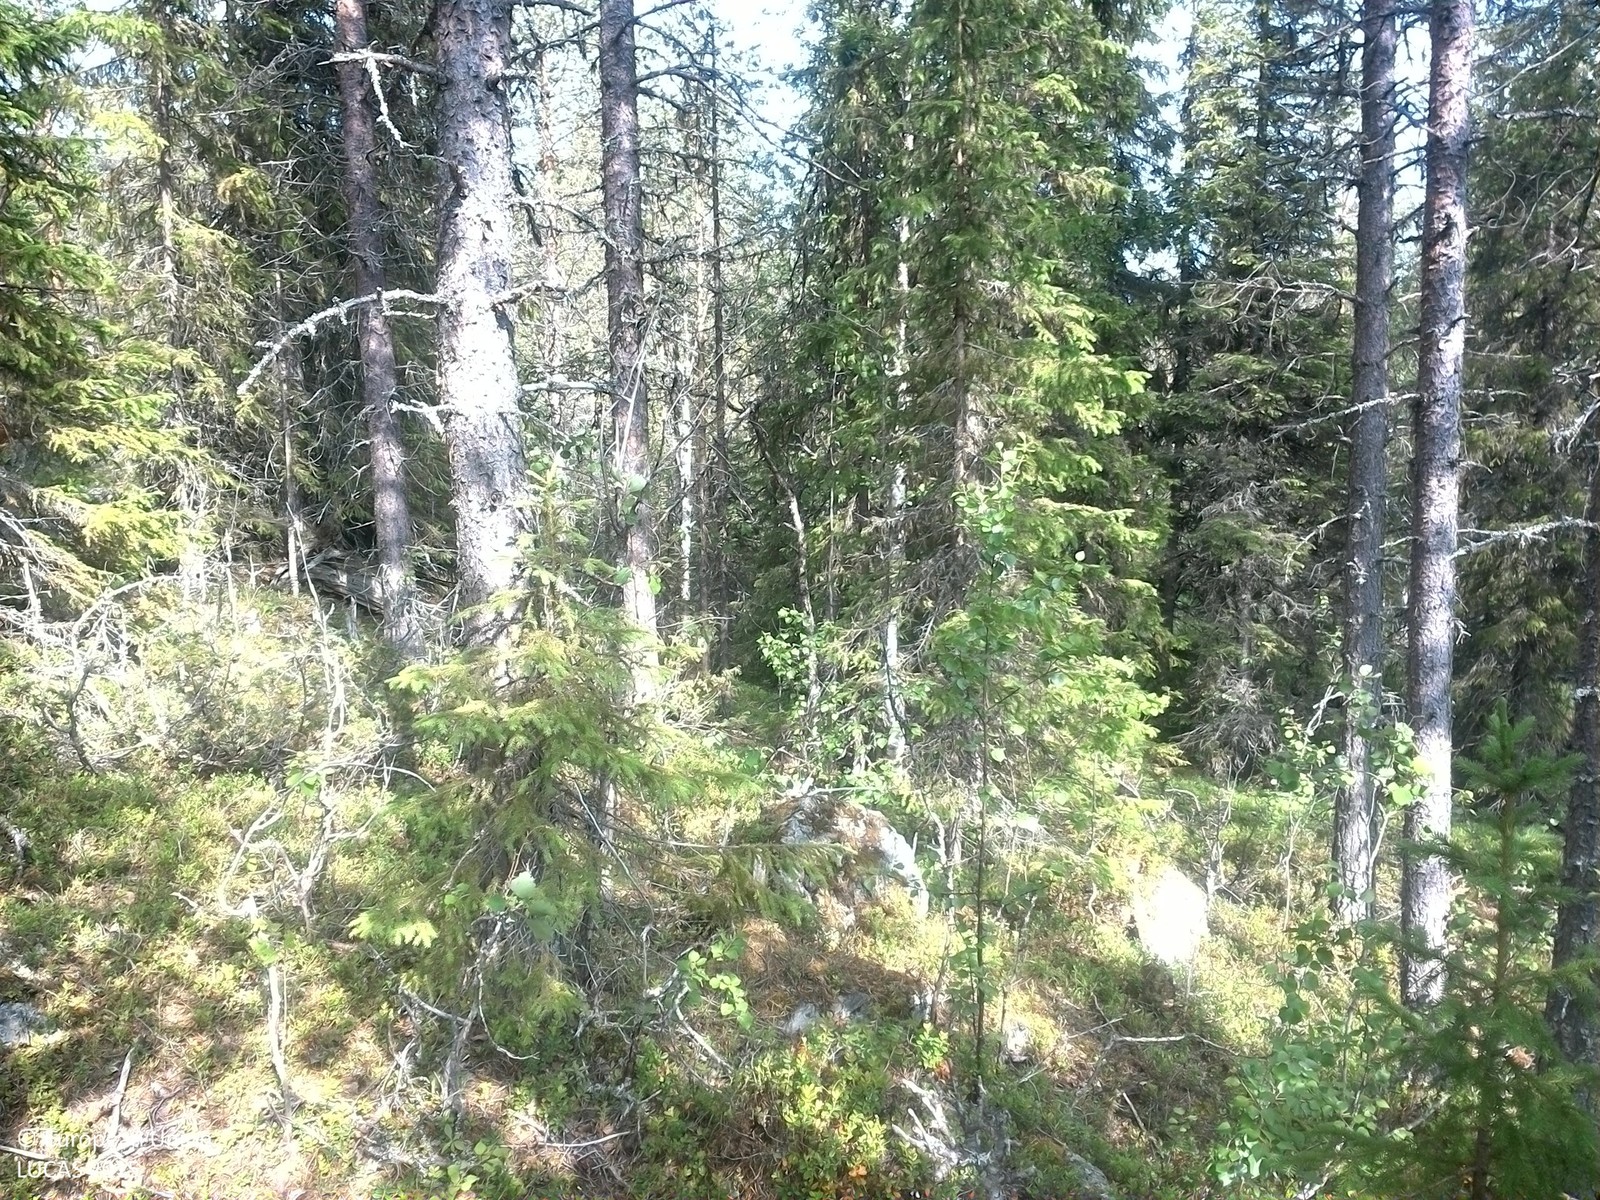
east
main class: Woodland
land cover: Other coniferous woodland
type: boreal forest
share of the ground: 50 - 75 %
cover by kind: coniferous forest trees 50 %, shrubs 25 %, broadleaved forest trees 10 %, lichens and mosses 10 %, consolidated bare surface 5 %
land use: Forestry
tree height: > 5 m
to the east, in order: Other coniferous woodland; Inland fresh running water; Pine dominated mixed woodland; Inland marshes; Pine dominated coniferous woodland; Rocks and stones; Pine dominated coniferous woodland; Inland marshes; Pine dominated mixed woodland; Rocks and stones; Pine dominated mixed woodland; Rivers and streams; Other coniferous woodland; Pine dominated coniferous woodland
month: July
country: SE
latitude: 64.7109
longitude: 15.7379
